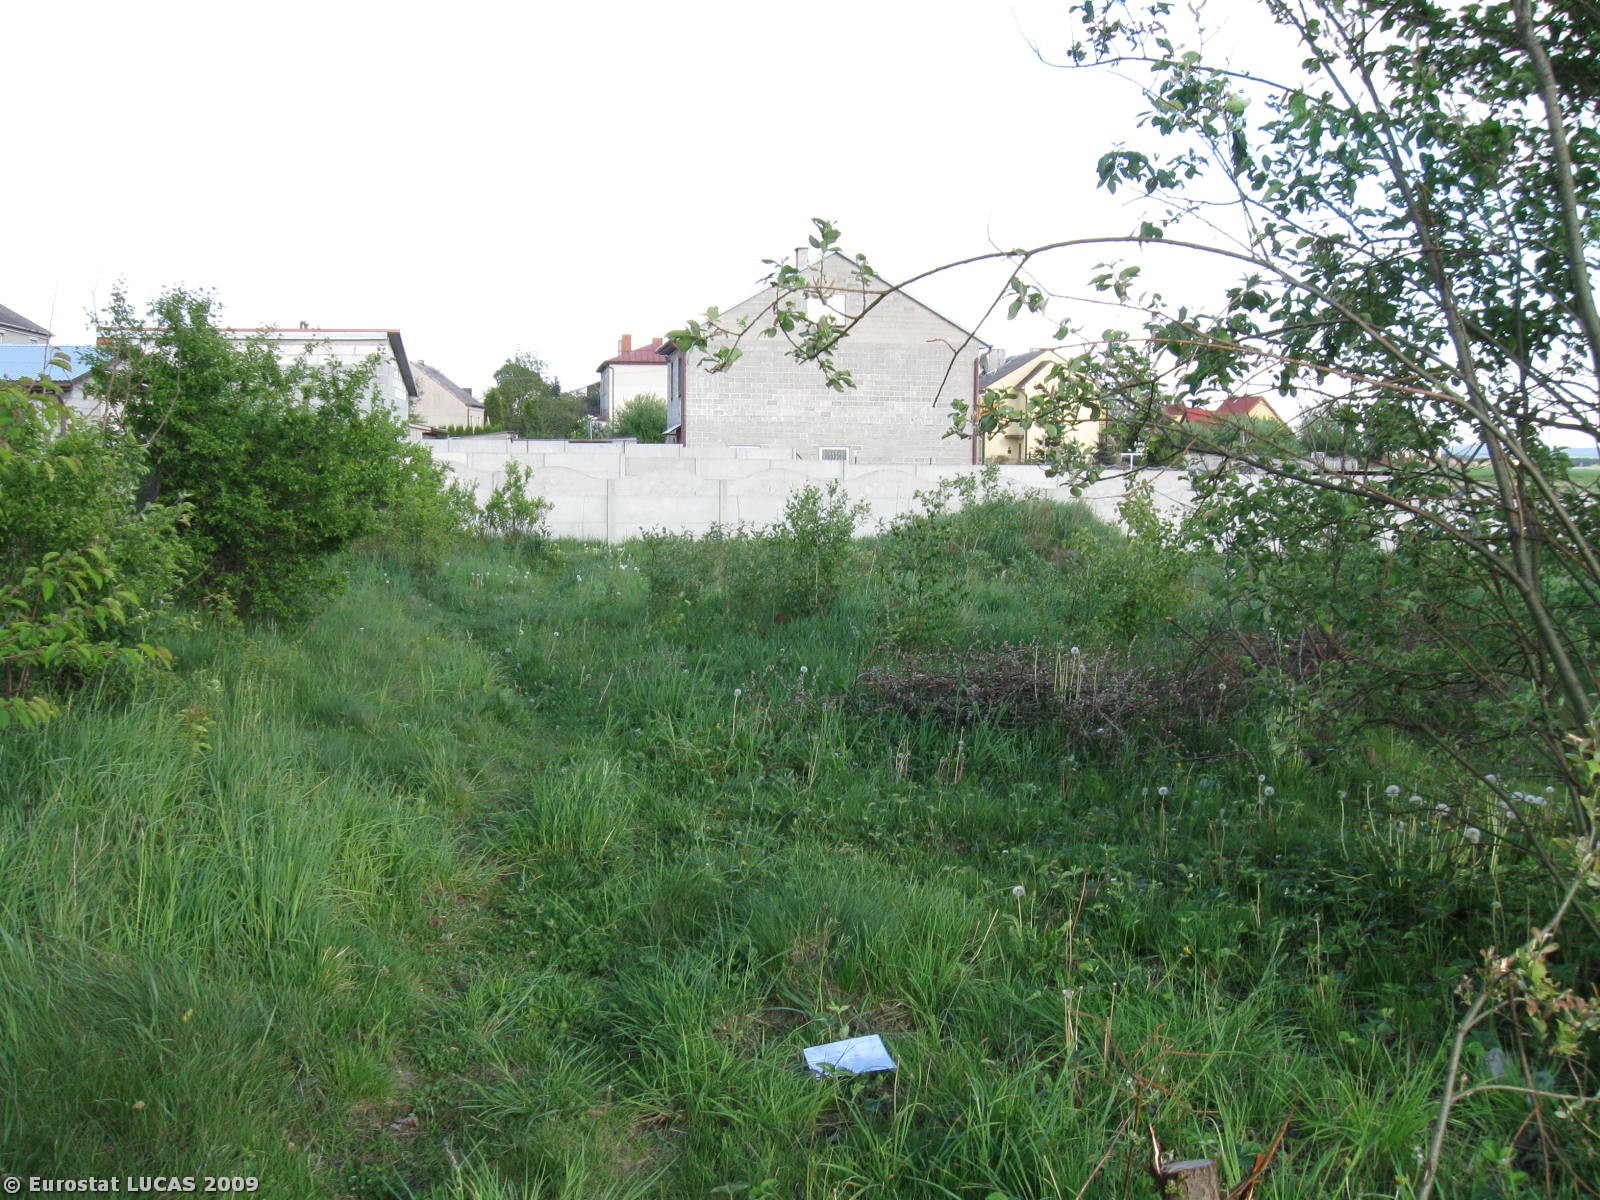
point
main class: Shrubland
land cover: Shrubland without tree cover
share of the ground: > 75 %
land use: Unused
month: May
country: PL
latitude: 50.8877
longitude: 20.7741
